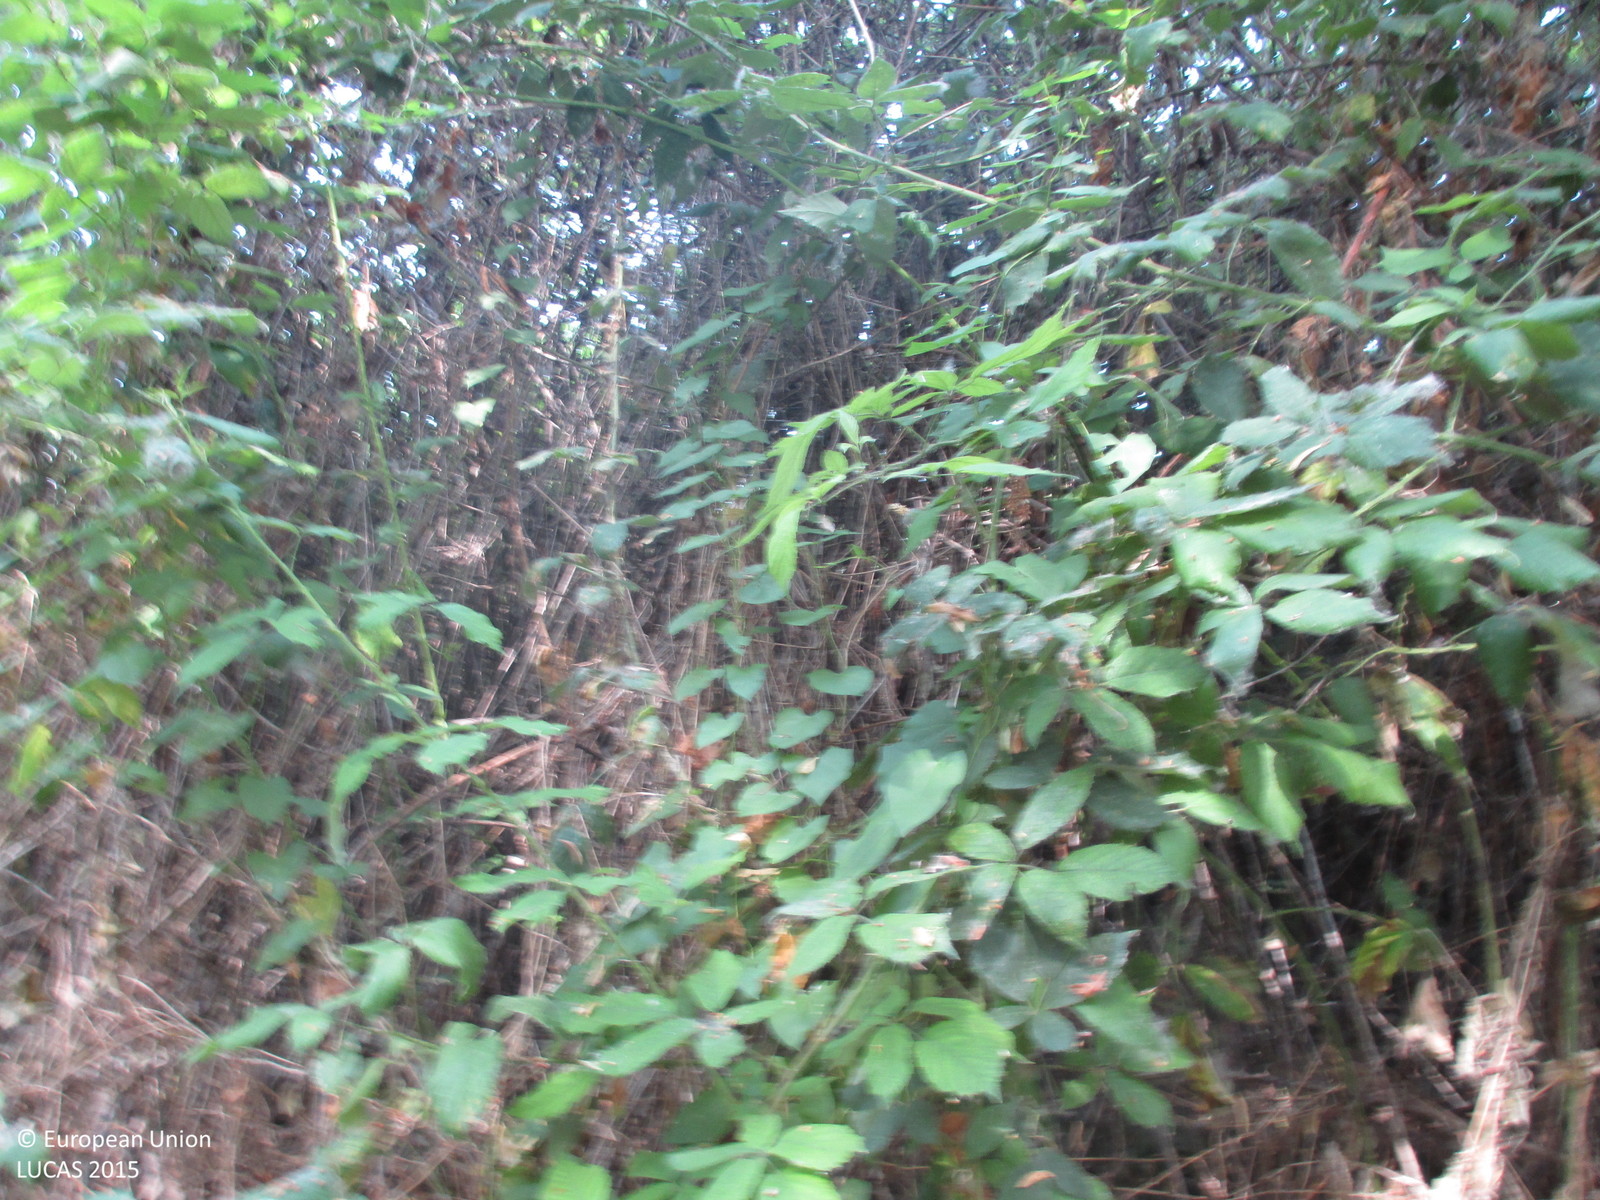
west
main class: Woodland
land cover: Broadleaved woodland
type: floodplain forest
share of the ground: > 75 %
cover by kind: broadleaved forest trees 100 %
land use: Semi-natural and natural areas not in use
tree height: > 5 m
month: July
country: ES
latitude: 42.1725
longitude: 0.3337
